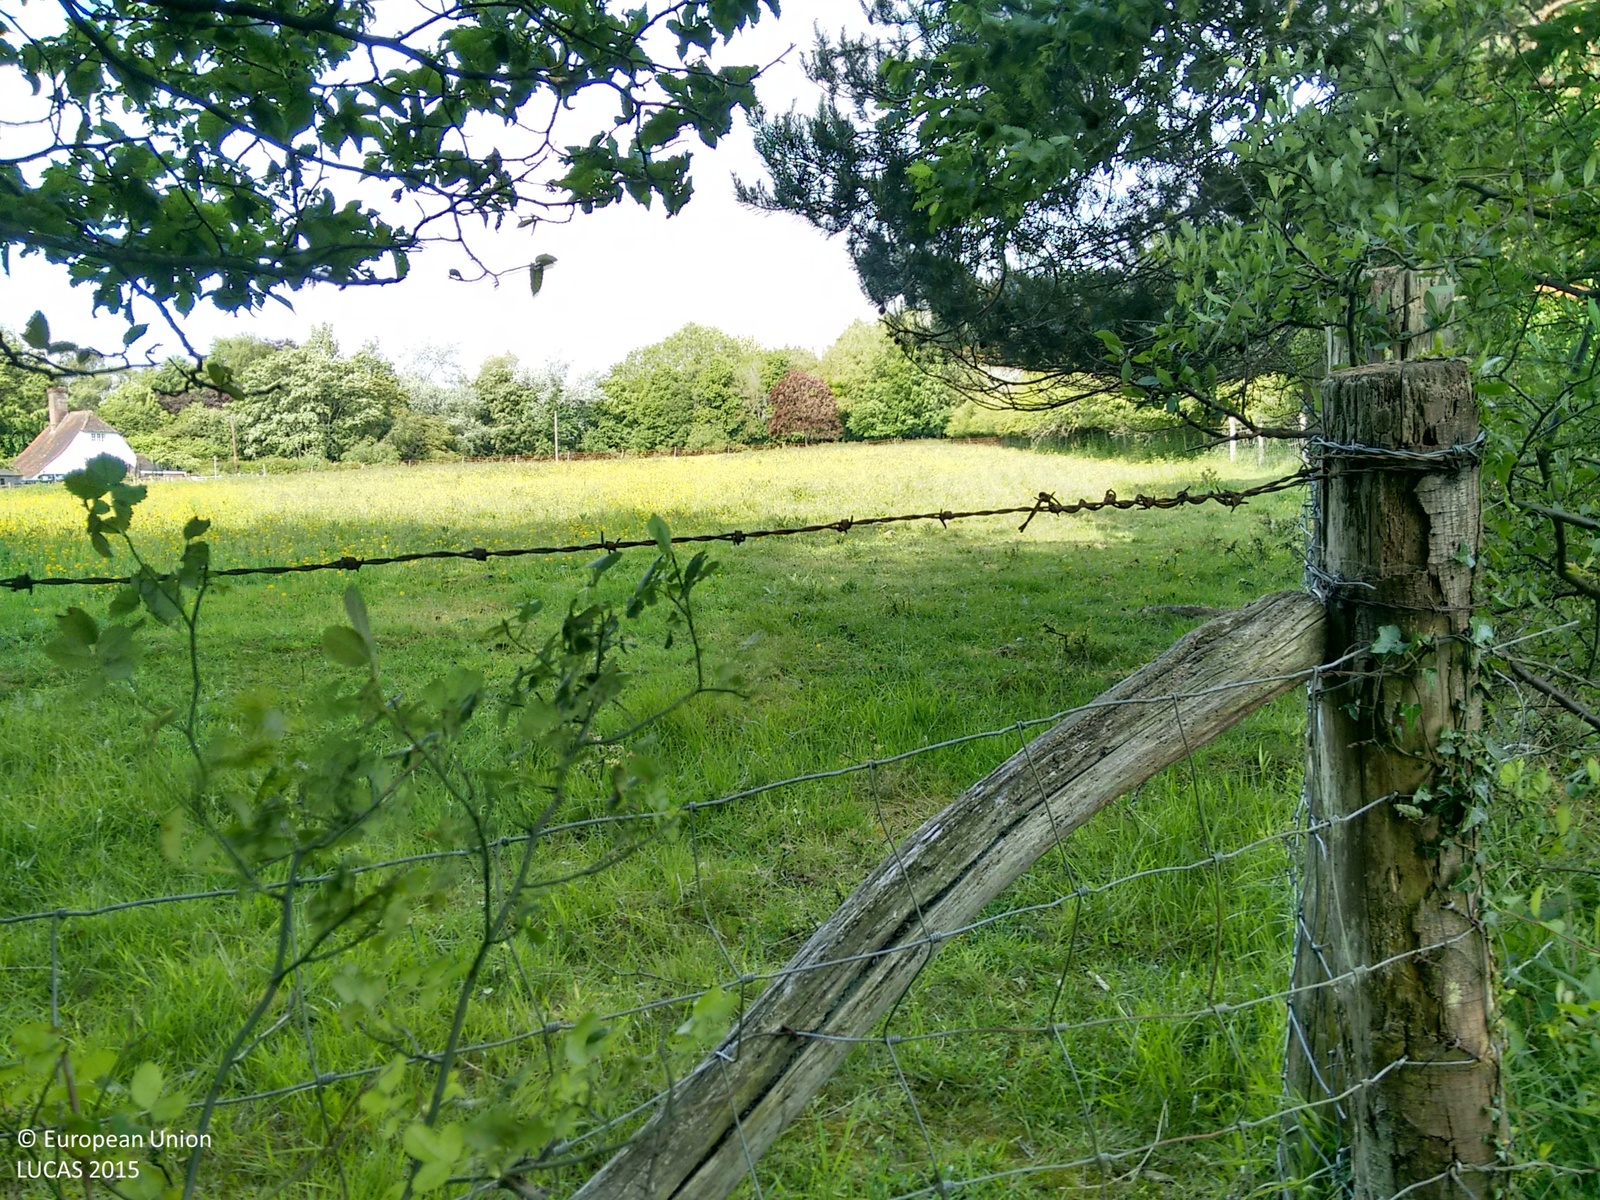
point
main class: Grassland
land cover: Grassland without tree/shrub cover
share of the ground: > 75 %
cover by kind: herbaceous plants 100 %
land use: Agriculture (excluding fallow land and kitchen gardens)
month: June
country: GB
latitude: 50.9864
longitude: 0.5564
